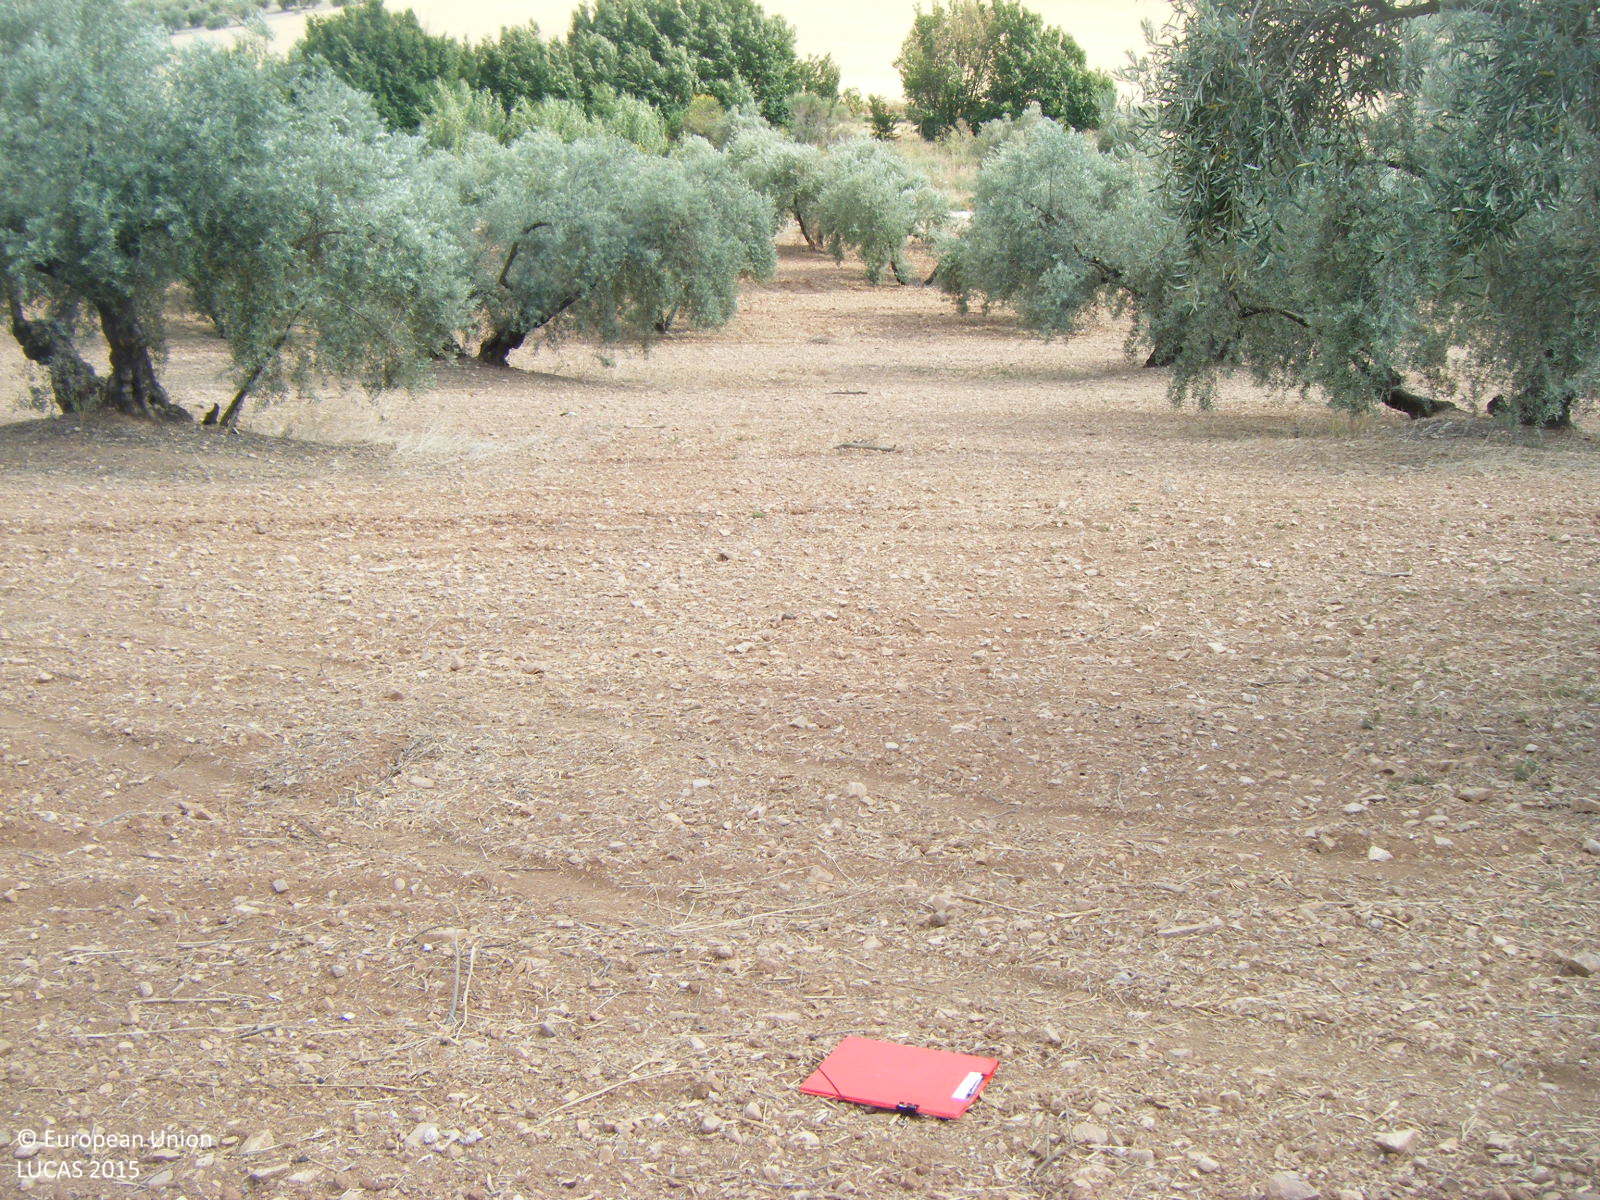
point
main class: Cropland
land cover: Olive groves
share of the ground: 25 - 50 %
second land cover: Other bare soil
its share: > 75 %
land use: Agriculture (excluding fallow land and kitchen gardens)
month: May
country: ES
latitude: 37.1924
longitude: -4.4293
